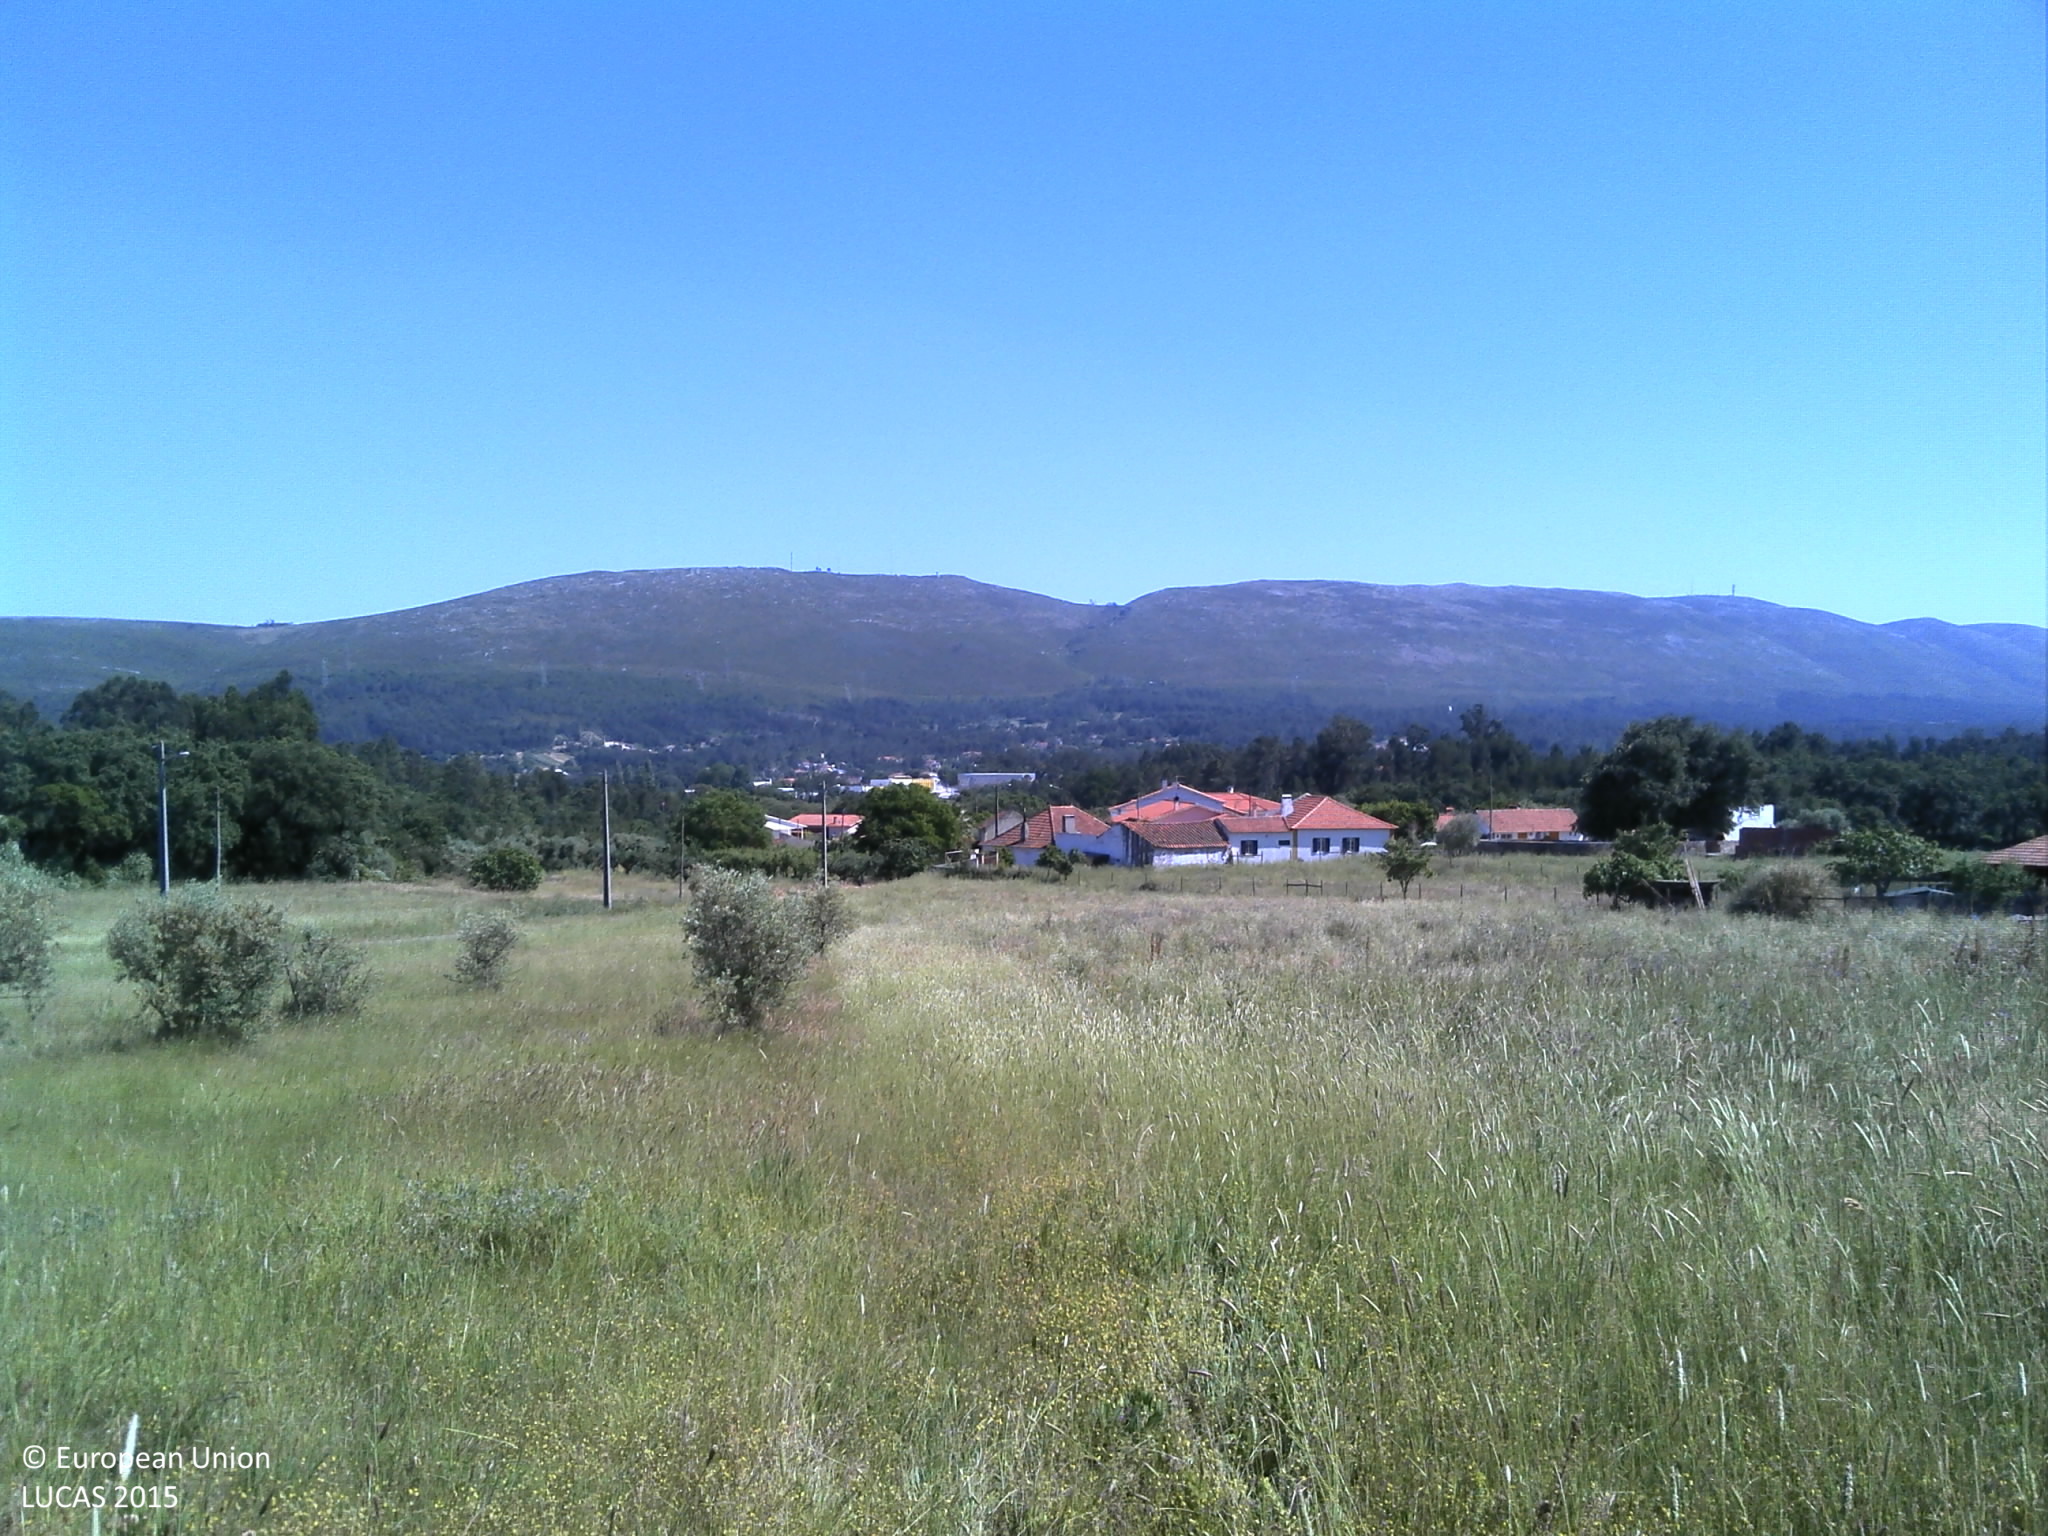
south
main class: Grassland
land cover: Grassland with sparse tree/shrub cover
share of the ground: > 75 %
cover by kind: herbaceous plants 75 %, unconsolidated bare surface 15 %, broadleaved forest trees 5 %
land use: Agriculture (excluding fallow land and kitchen gardens)
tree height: < 5 m
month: May
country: PT
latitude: 39.6025
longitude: -8.8701
